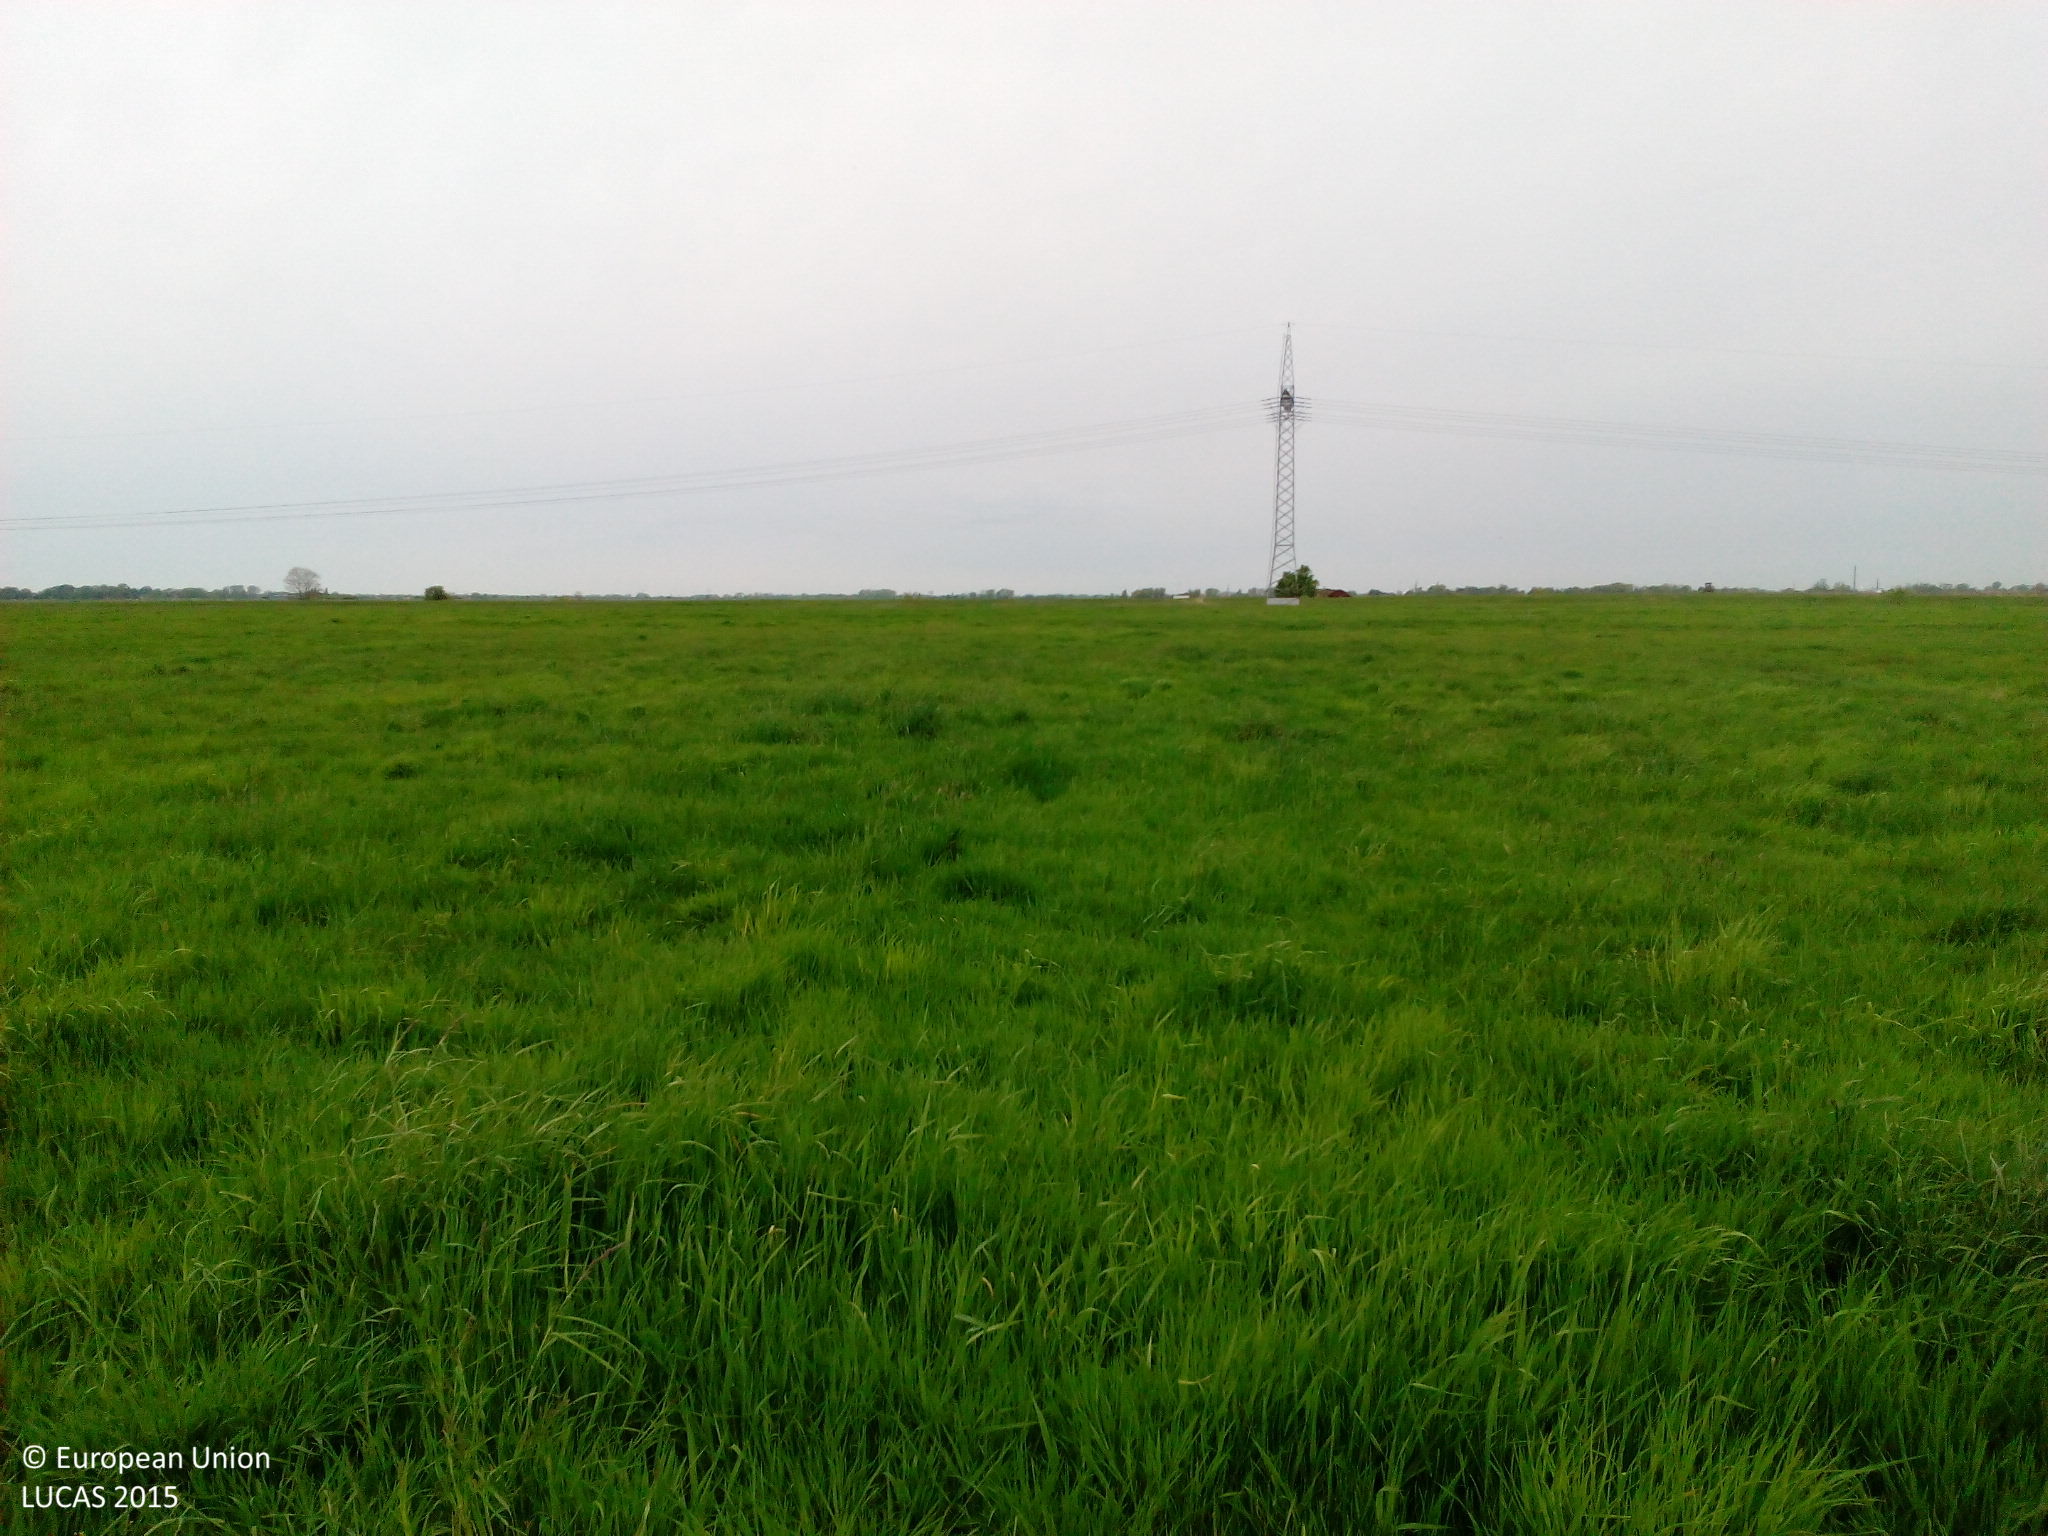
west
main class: Grassland
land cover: Grassland without tree/shrub cover
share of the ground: > 75 %
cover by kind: herbaceous plants 100 %
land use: Agriculture (excluding fallow land and kitchen gardens)
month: May
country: DE
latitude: 53.4474
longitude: 8.5702
